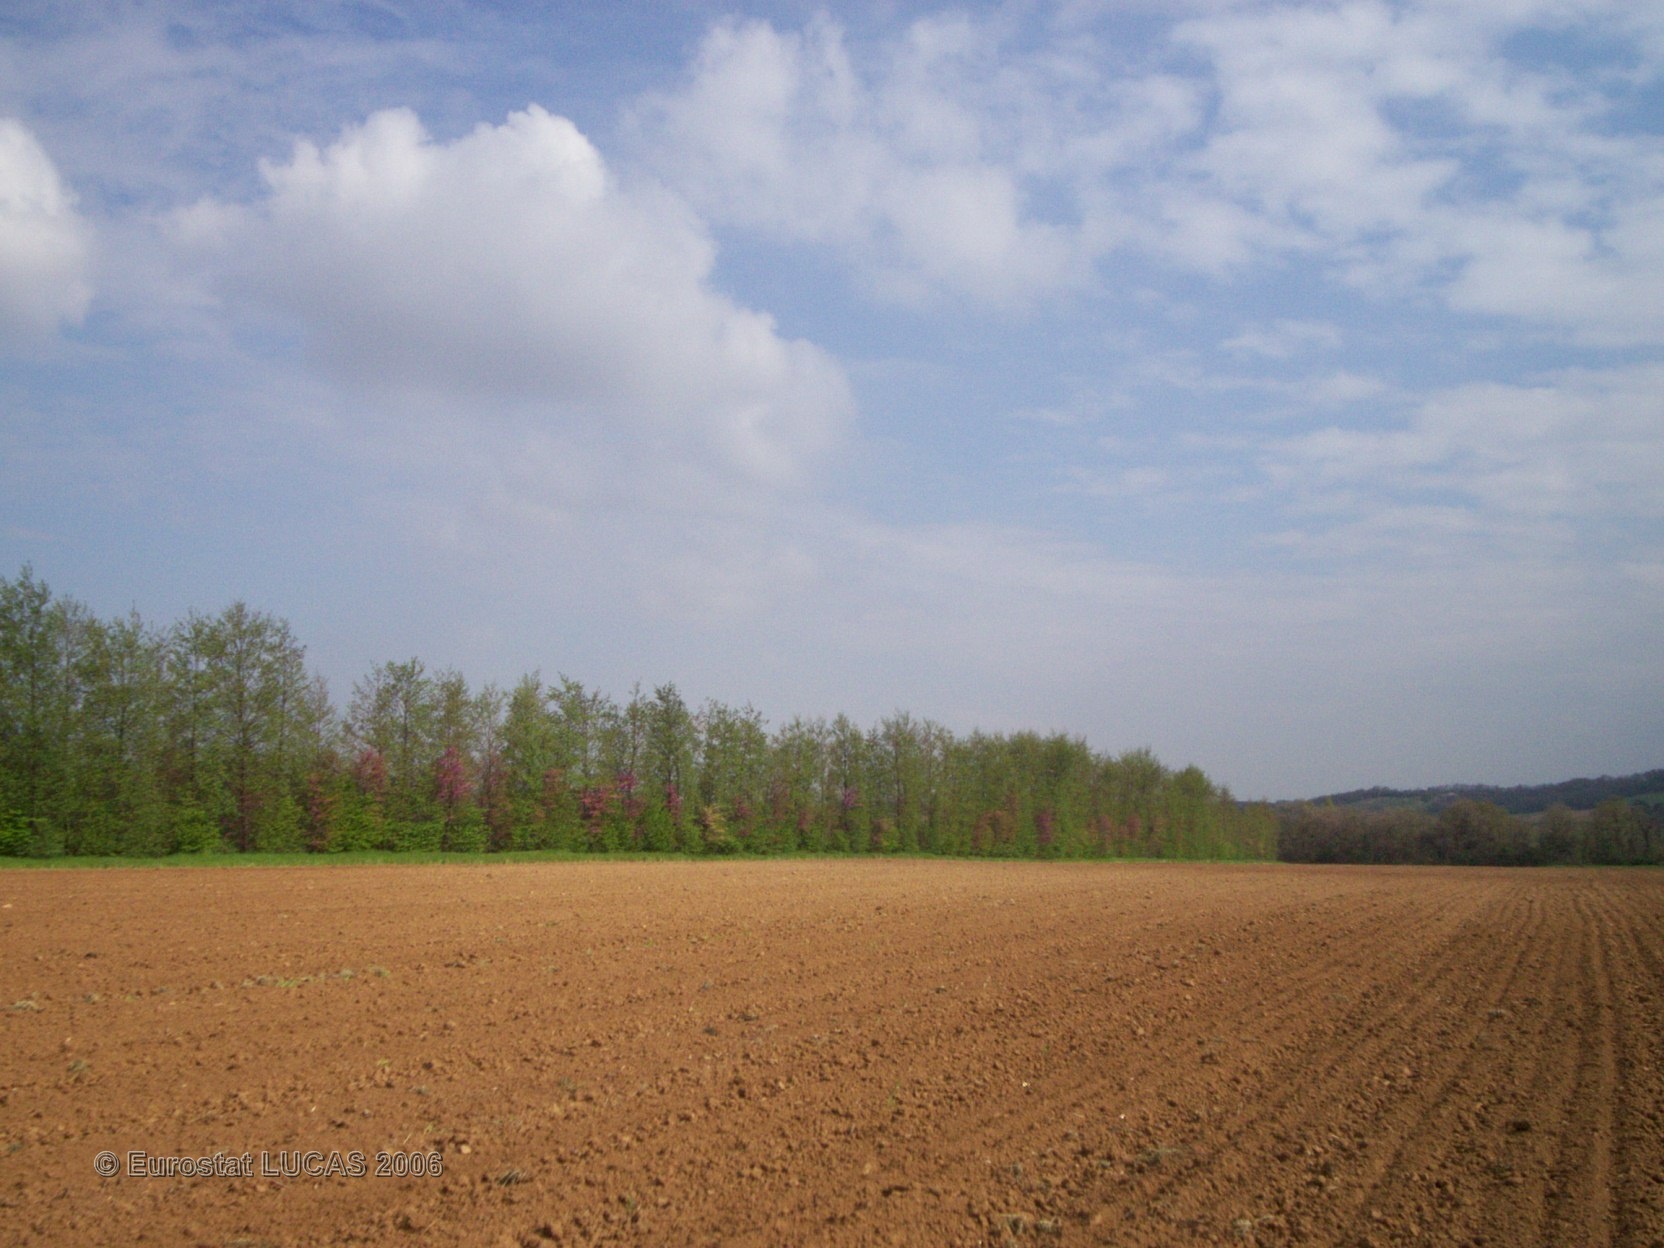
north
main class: Cropland
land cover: Maize
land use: Agriculture (excluding fallow land and kitchen gardens)
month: June
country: FR
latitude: 44.8026
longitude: 4.8859
